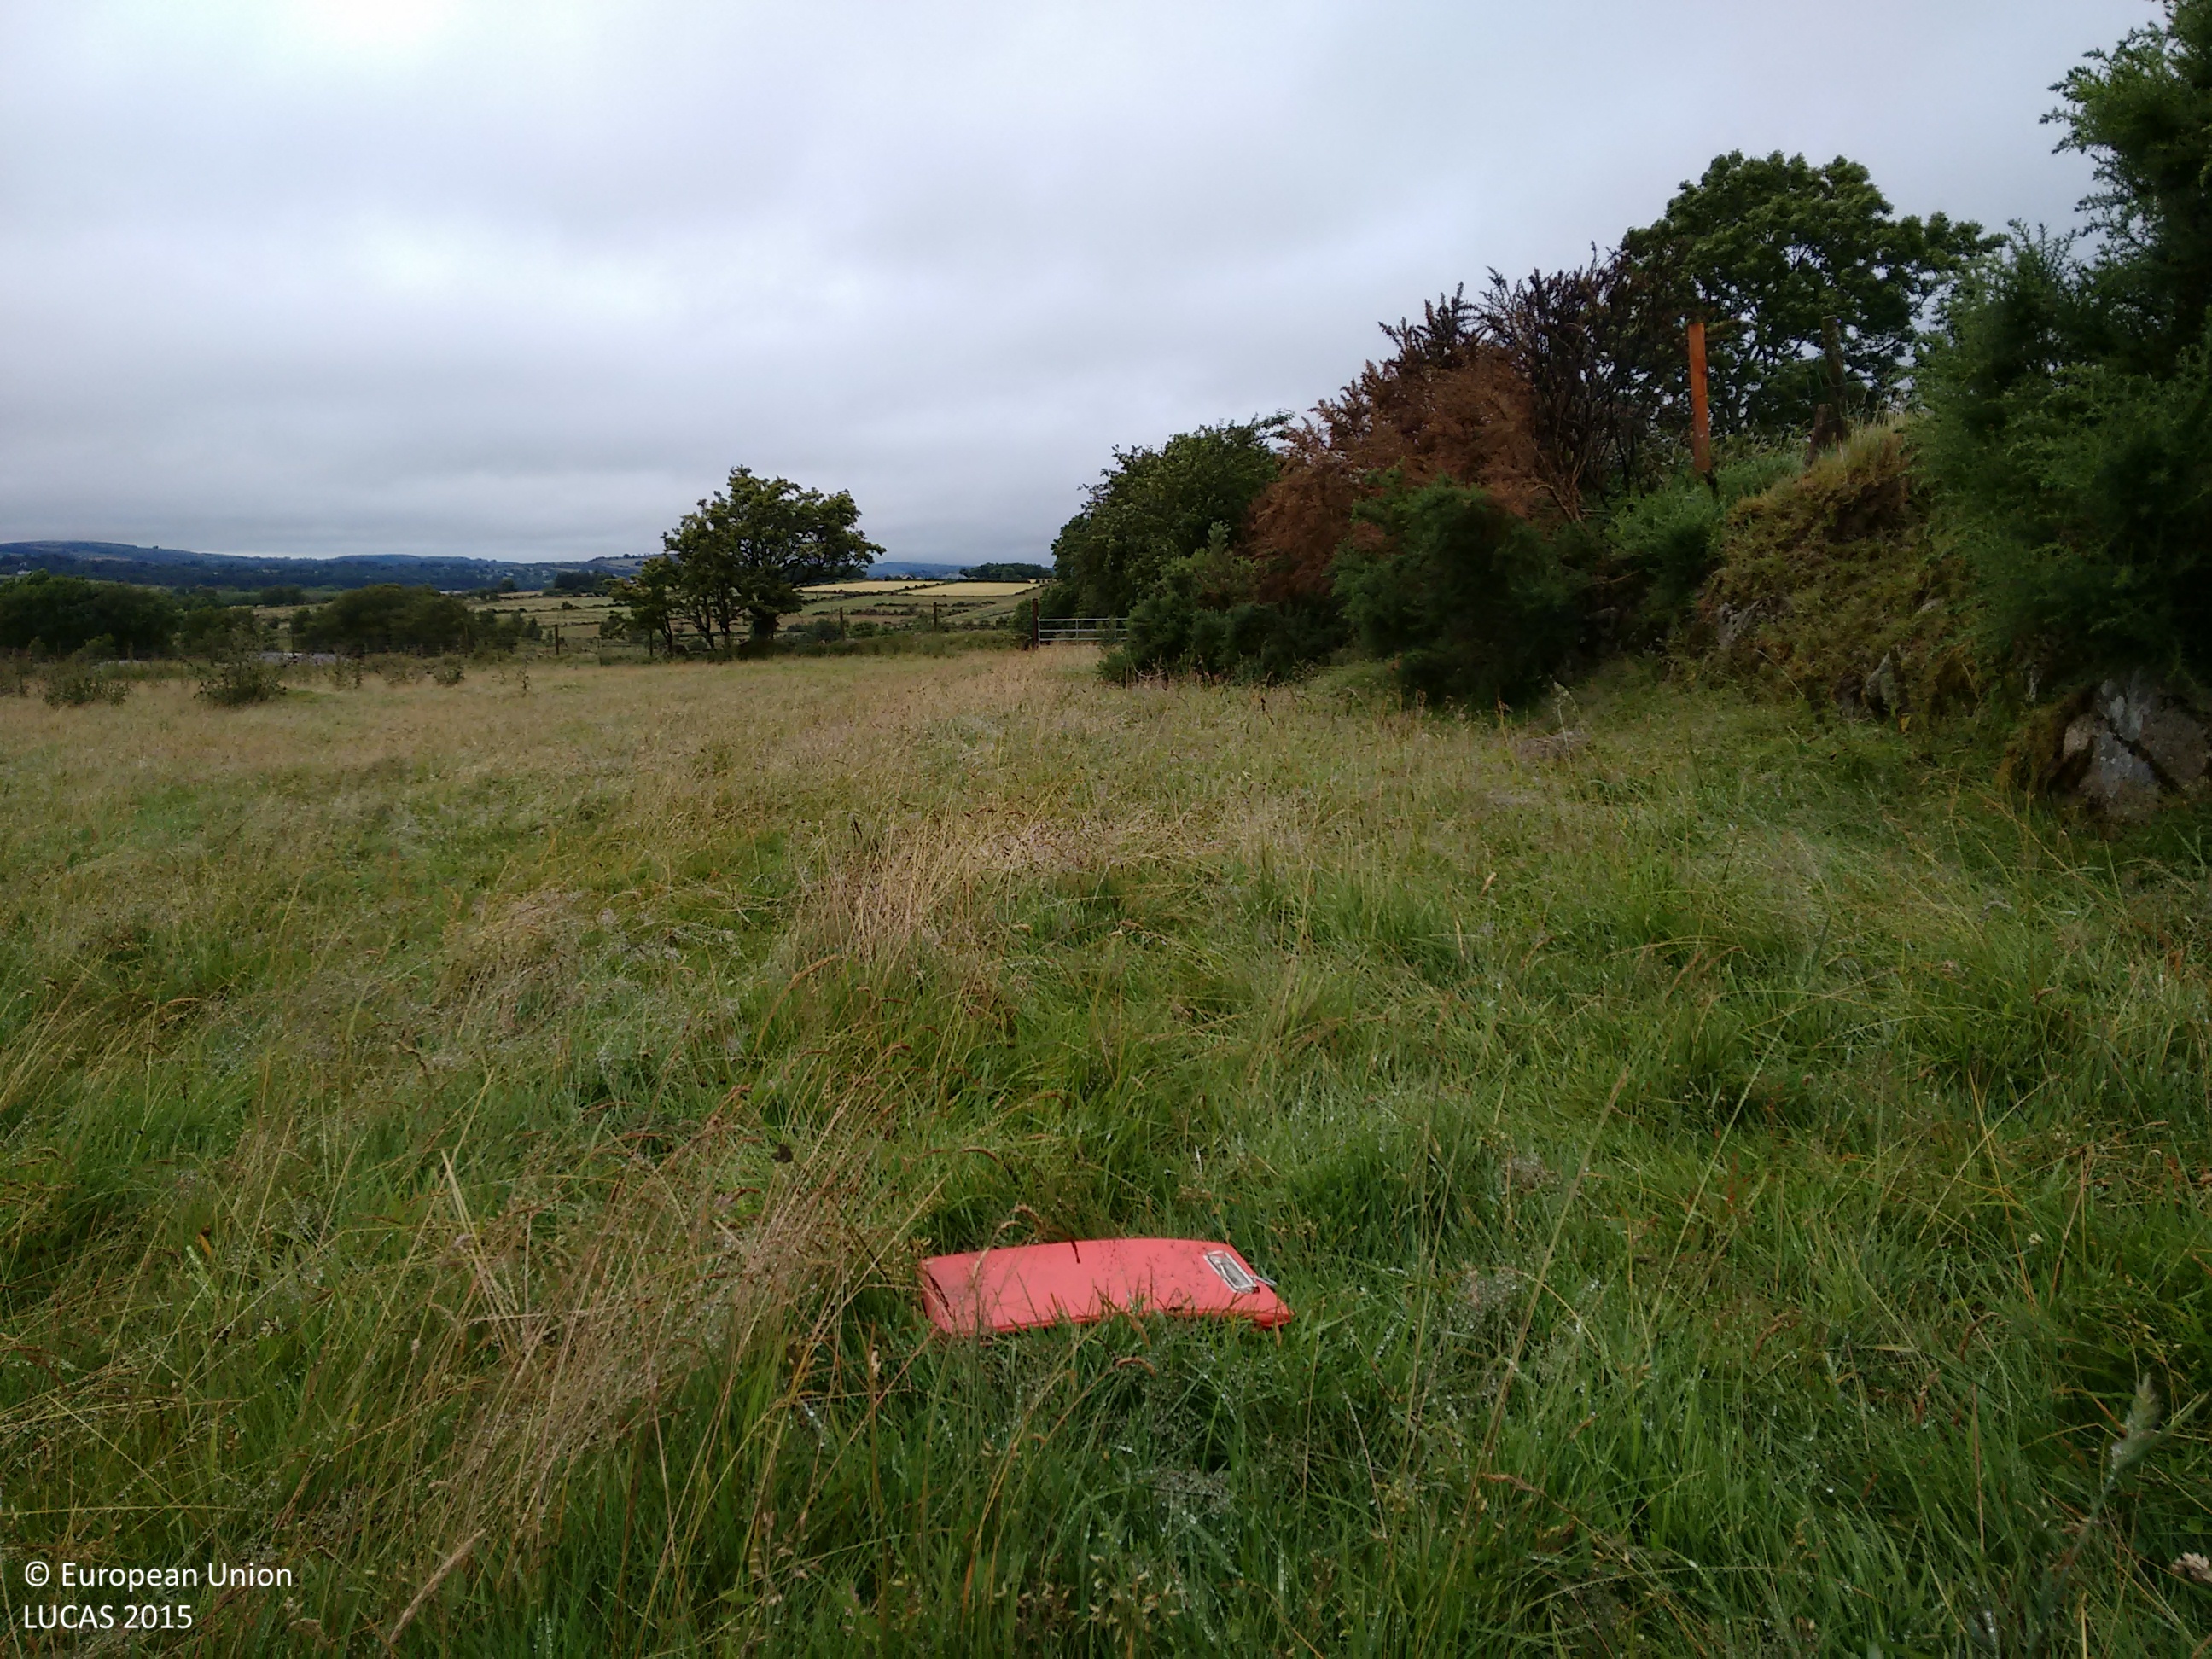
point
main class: Grassland
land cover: Grassland without tree/shrub cover
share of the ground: > 75 %
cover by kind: herbaceous plants 100 %
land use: Agriculture (excluding fallow land and kitchen gardens)
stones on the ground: < 10 %
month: July
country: IE
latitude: 53.0806
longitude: -6.5346
